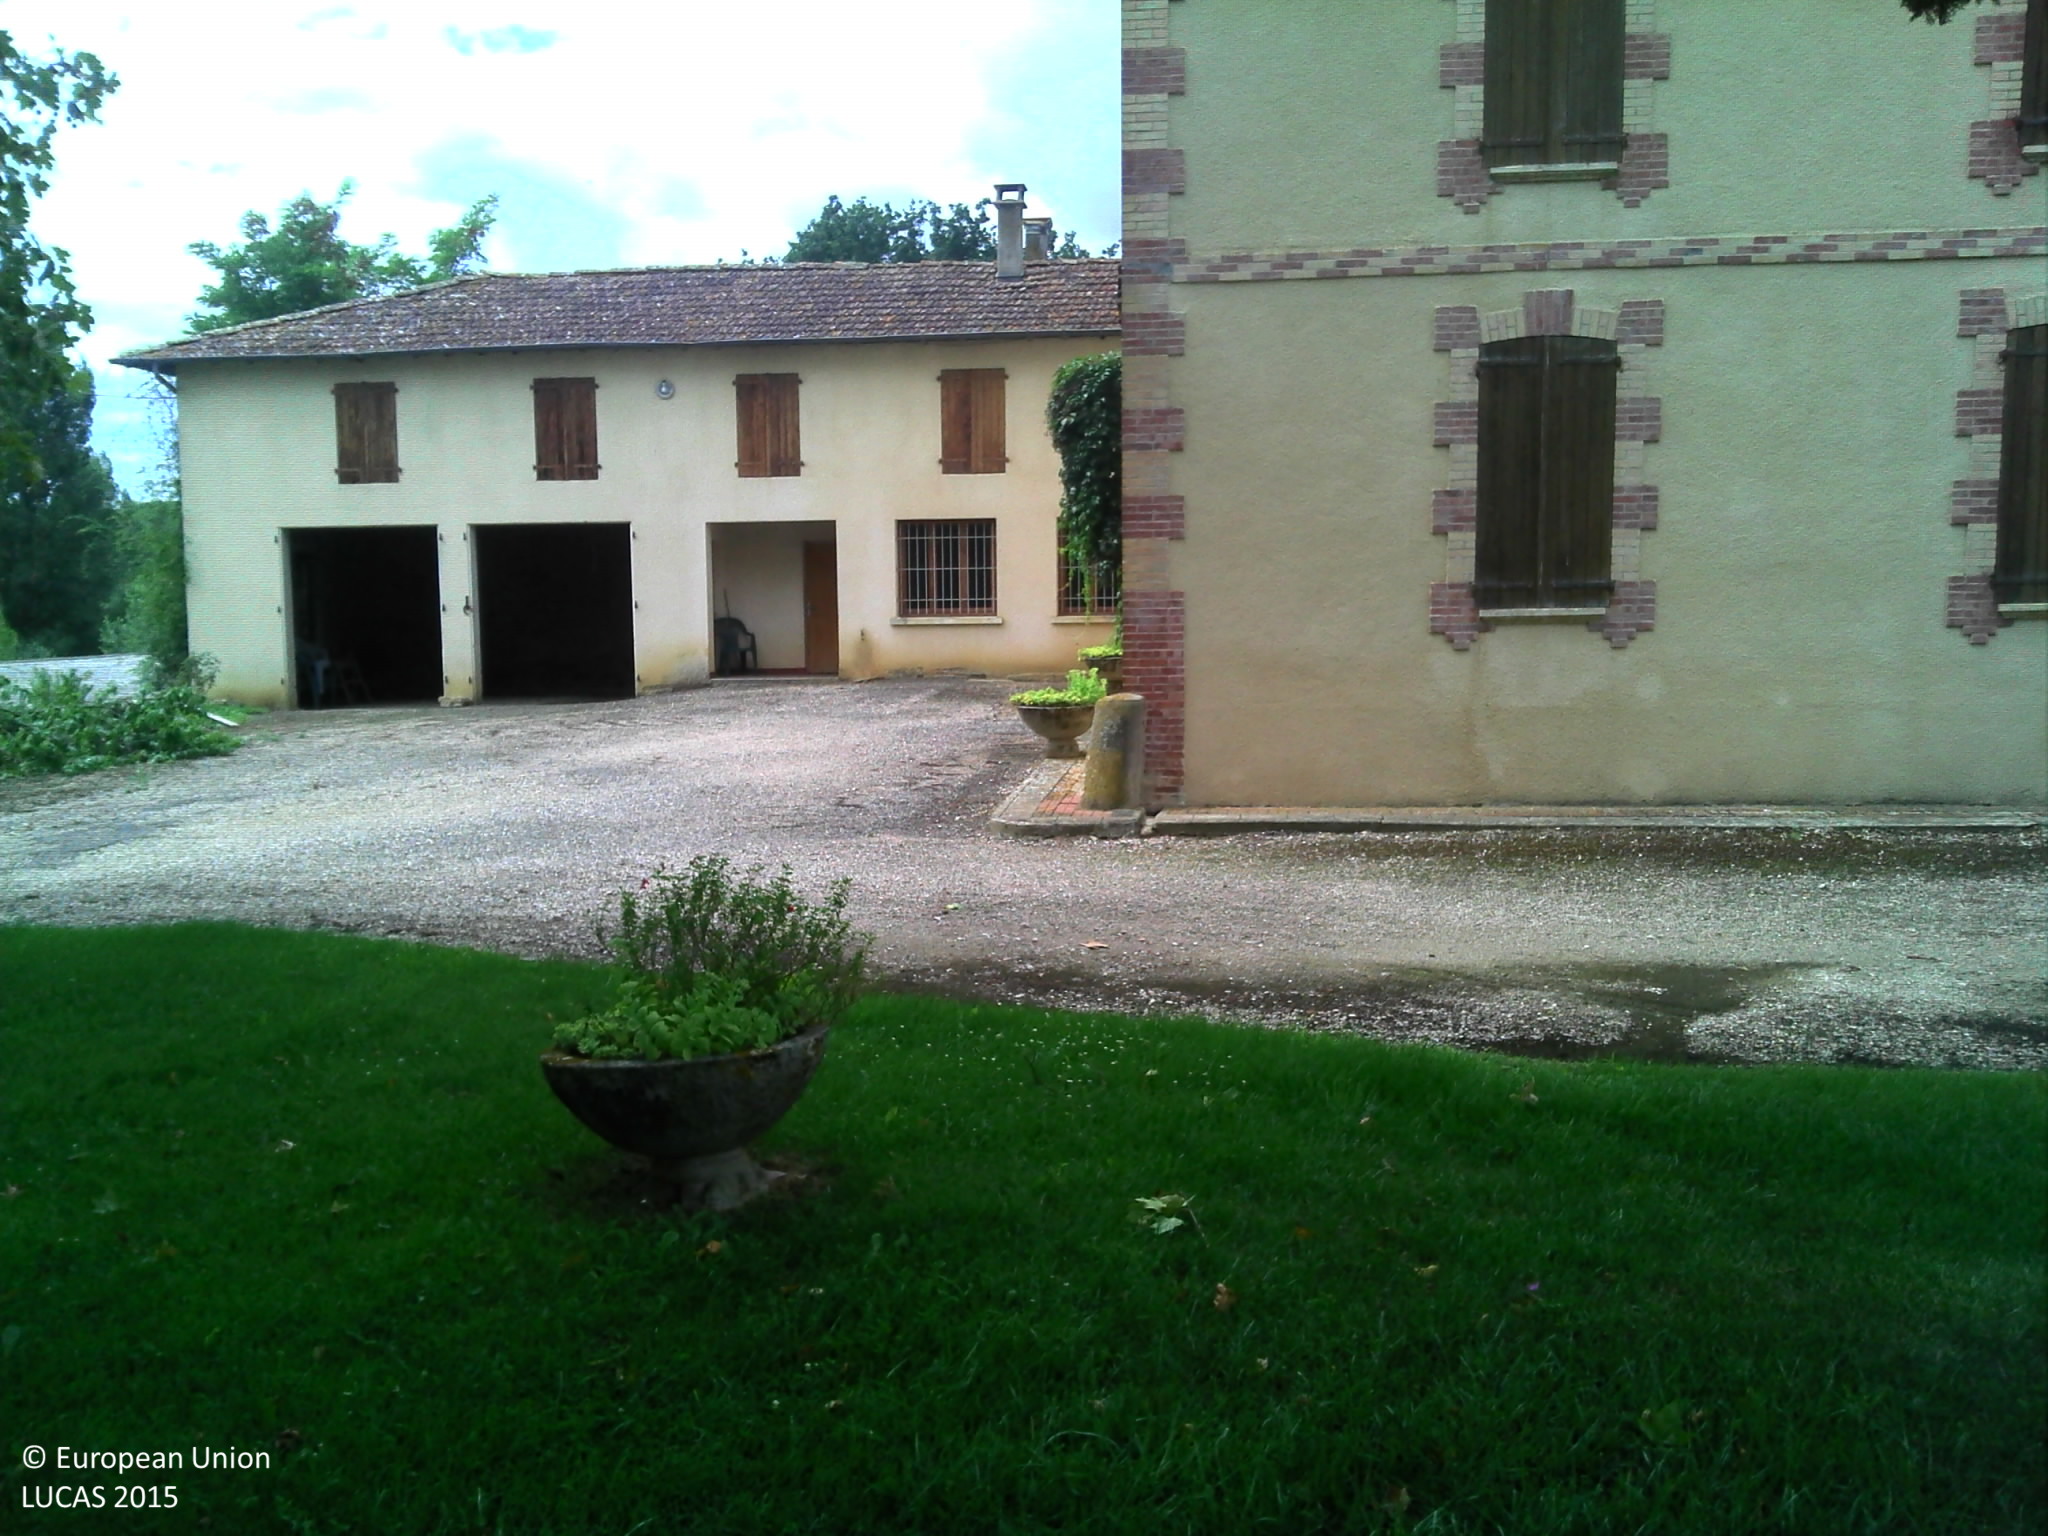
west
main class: Woodland
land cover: Pine dominated mixed woodland
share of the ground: > 75 %
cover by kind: coniferous forest trees 50 %, broadleaved forest trees 25 %, herbaceous plants 25 %
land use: Residential
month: August
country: FR
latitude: 43.4081
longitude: 0.7261
